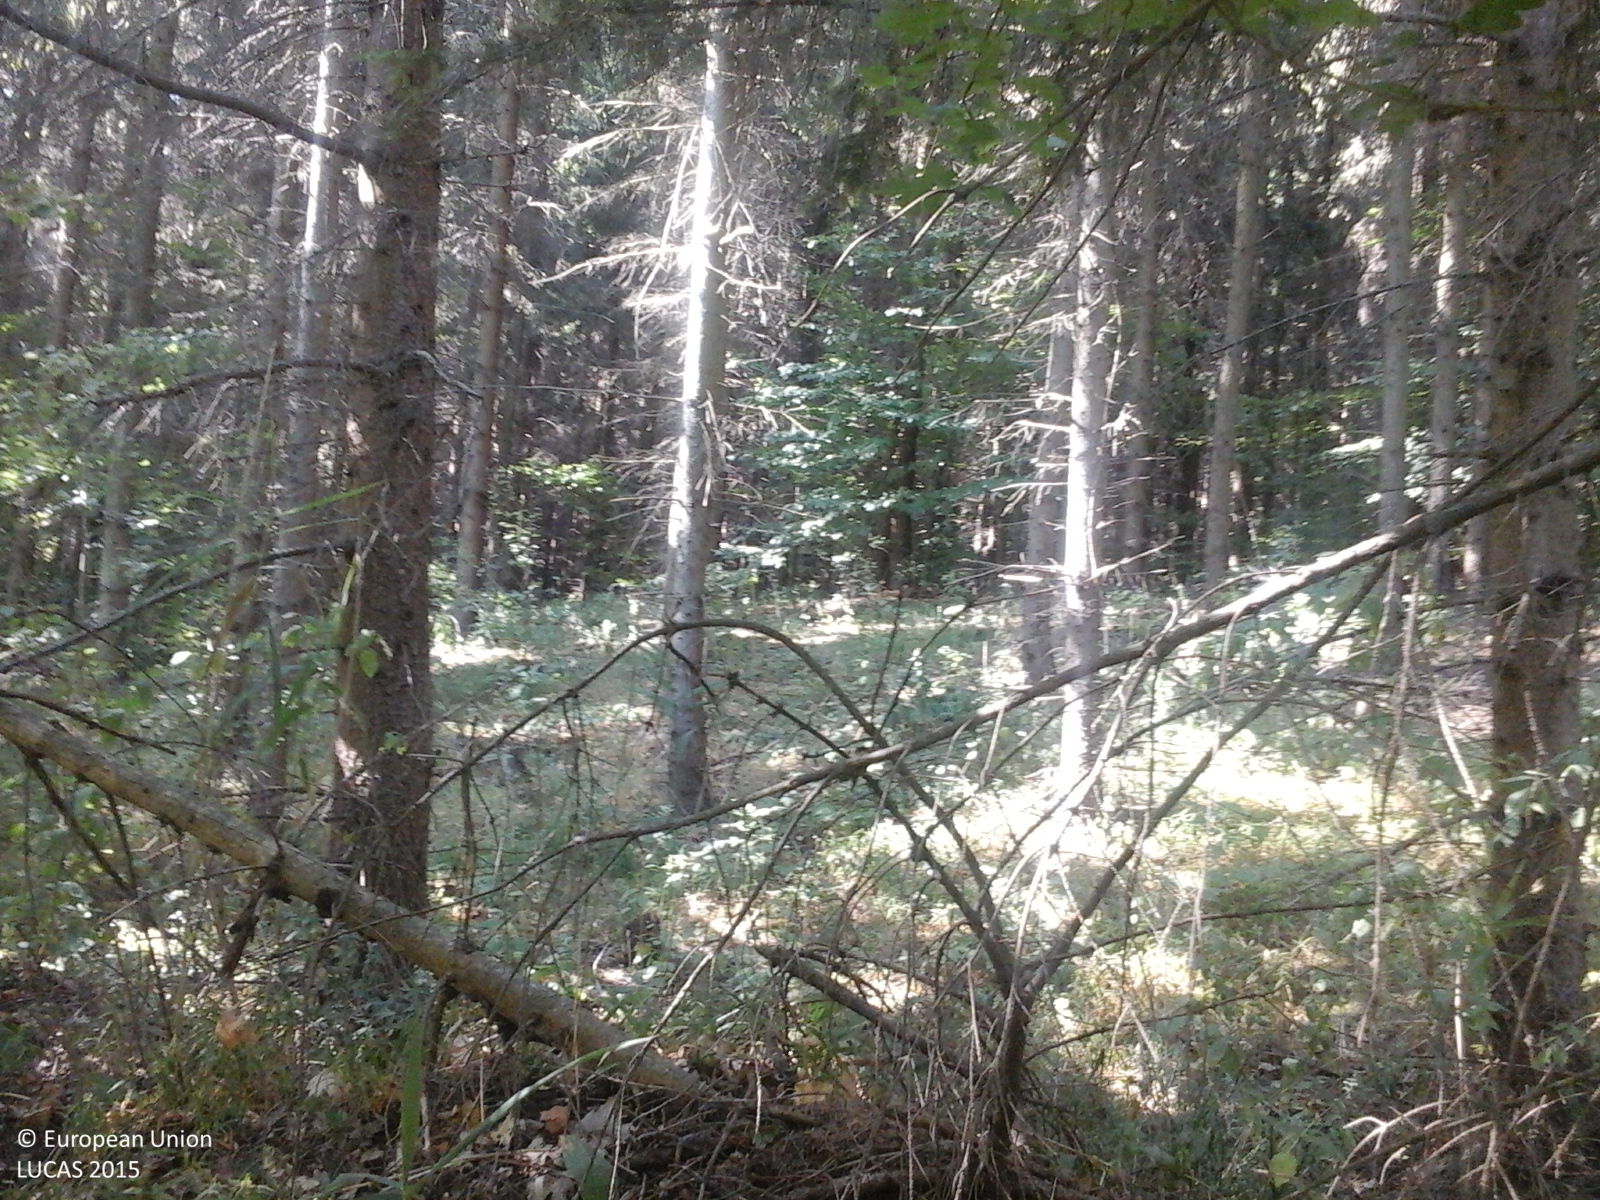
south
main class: Woodland
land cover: Spruce dominated coniferous woodland
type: alpine coniferous forest
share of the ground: > 75 %
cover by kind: coniferous forest trees 75 %, broadleaved forest trees 25 %
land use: Forestry
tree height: > 5 m
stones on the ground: 10 - 25 %
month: July
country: RO
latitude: 46.6110
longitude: 27.2476
